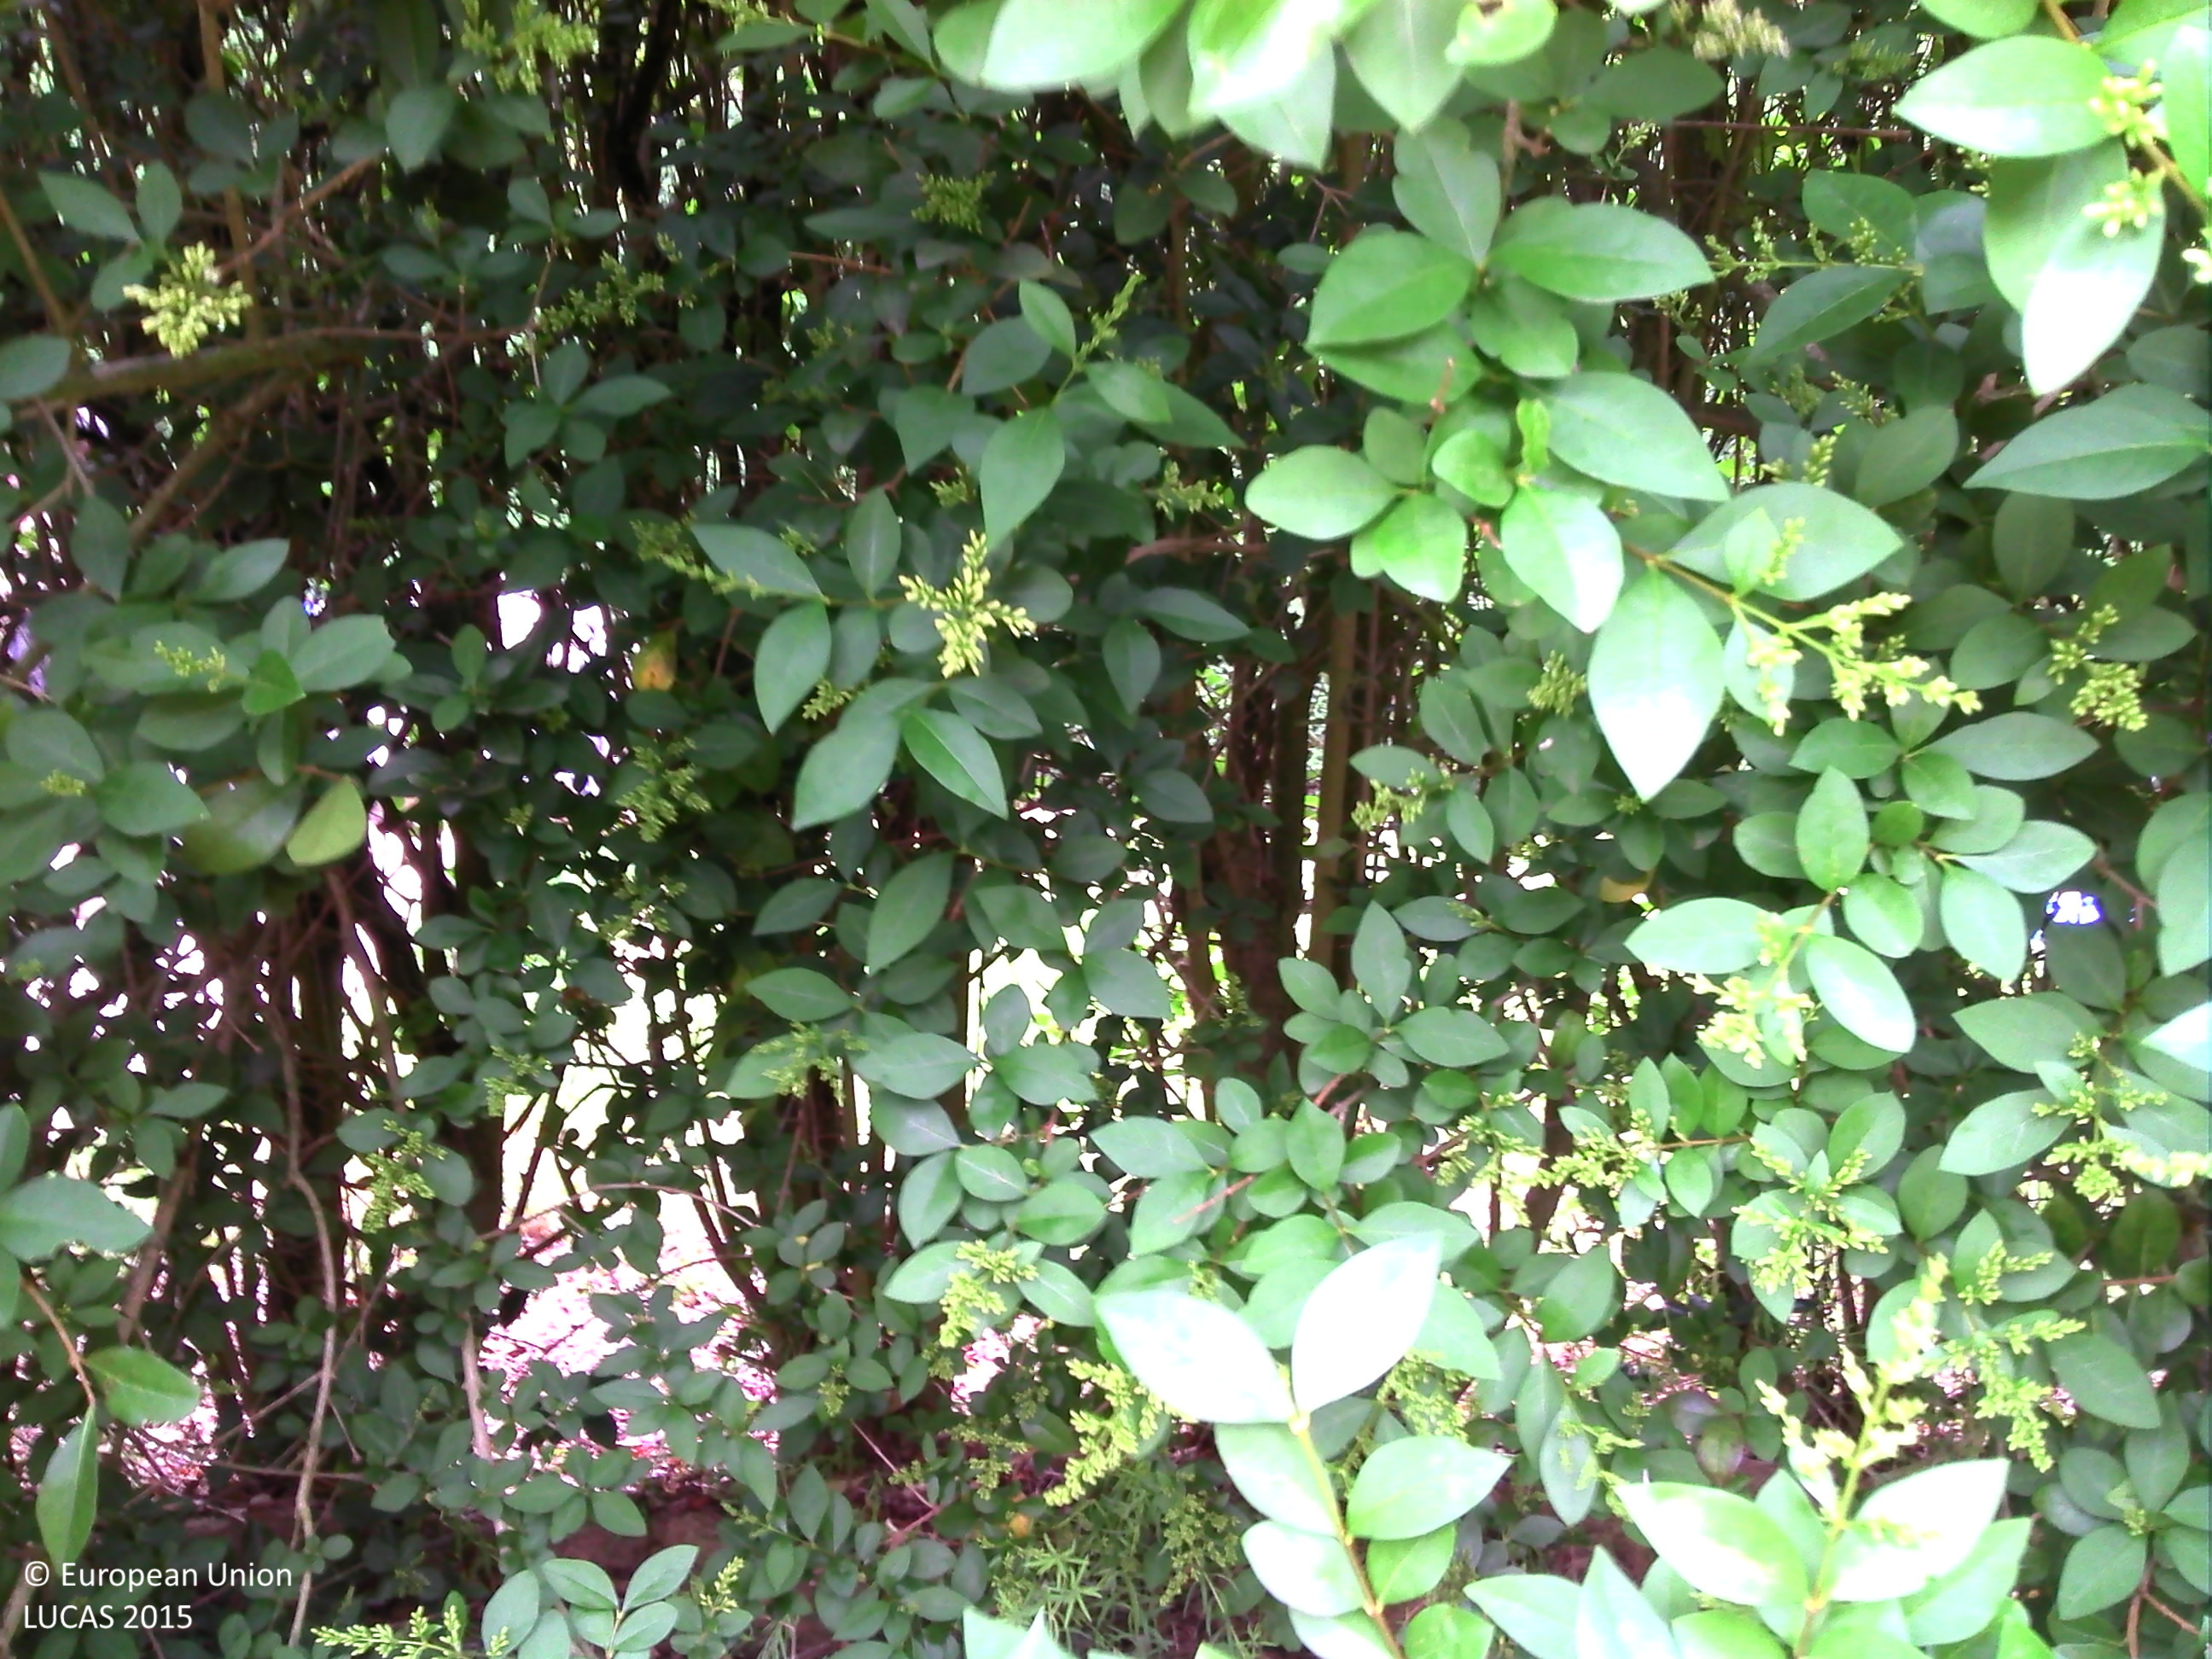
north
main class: Grassland
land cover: Grassland without tree/shrub cover
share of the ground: > 75 %
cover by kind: herbaceous plants 100 %
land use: Abandoned areas
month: June
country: BE
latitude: 50.6521
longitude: 5.4579
